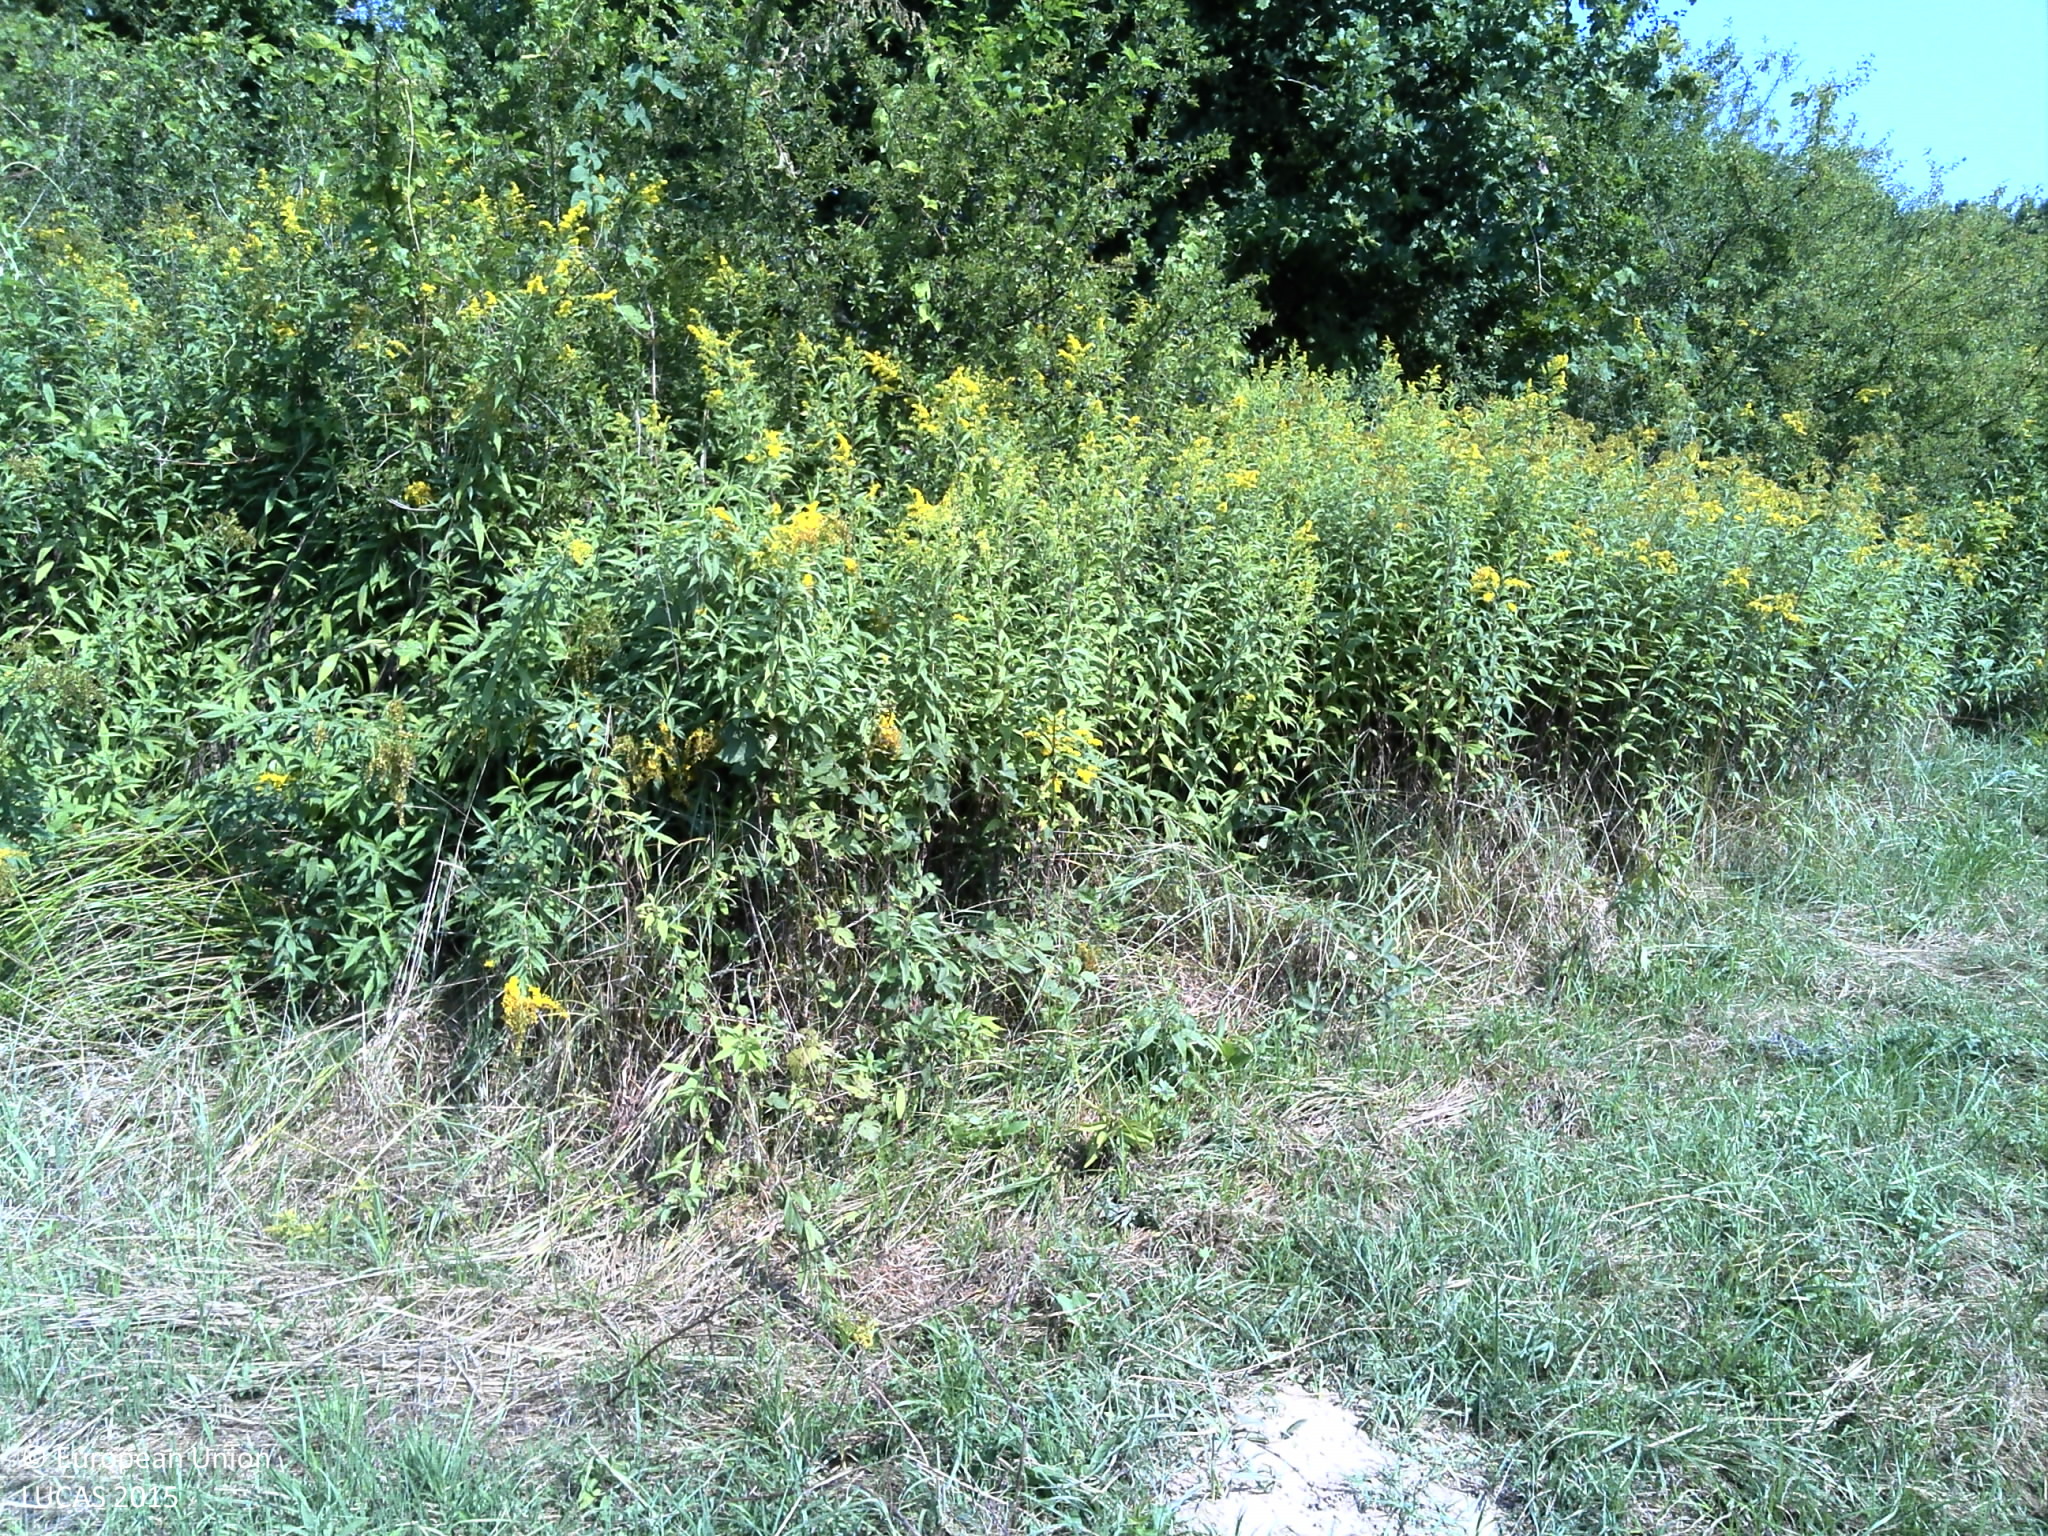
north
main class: Grassland
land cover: Spontaneously vegetated surfaces
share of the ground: > 75 %
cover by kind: herbaceous plants 100 %
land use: Agriculture (excluding fallow land and kitchen gardens)
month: August
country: HR
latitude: 45.5692
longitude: 16.8803
